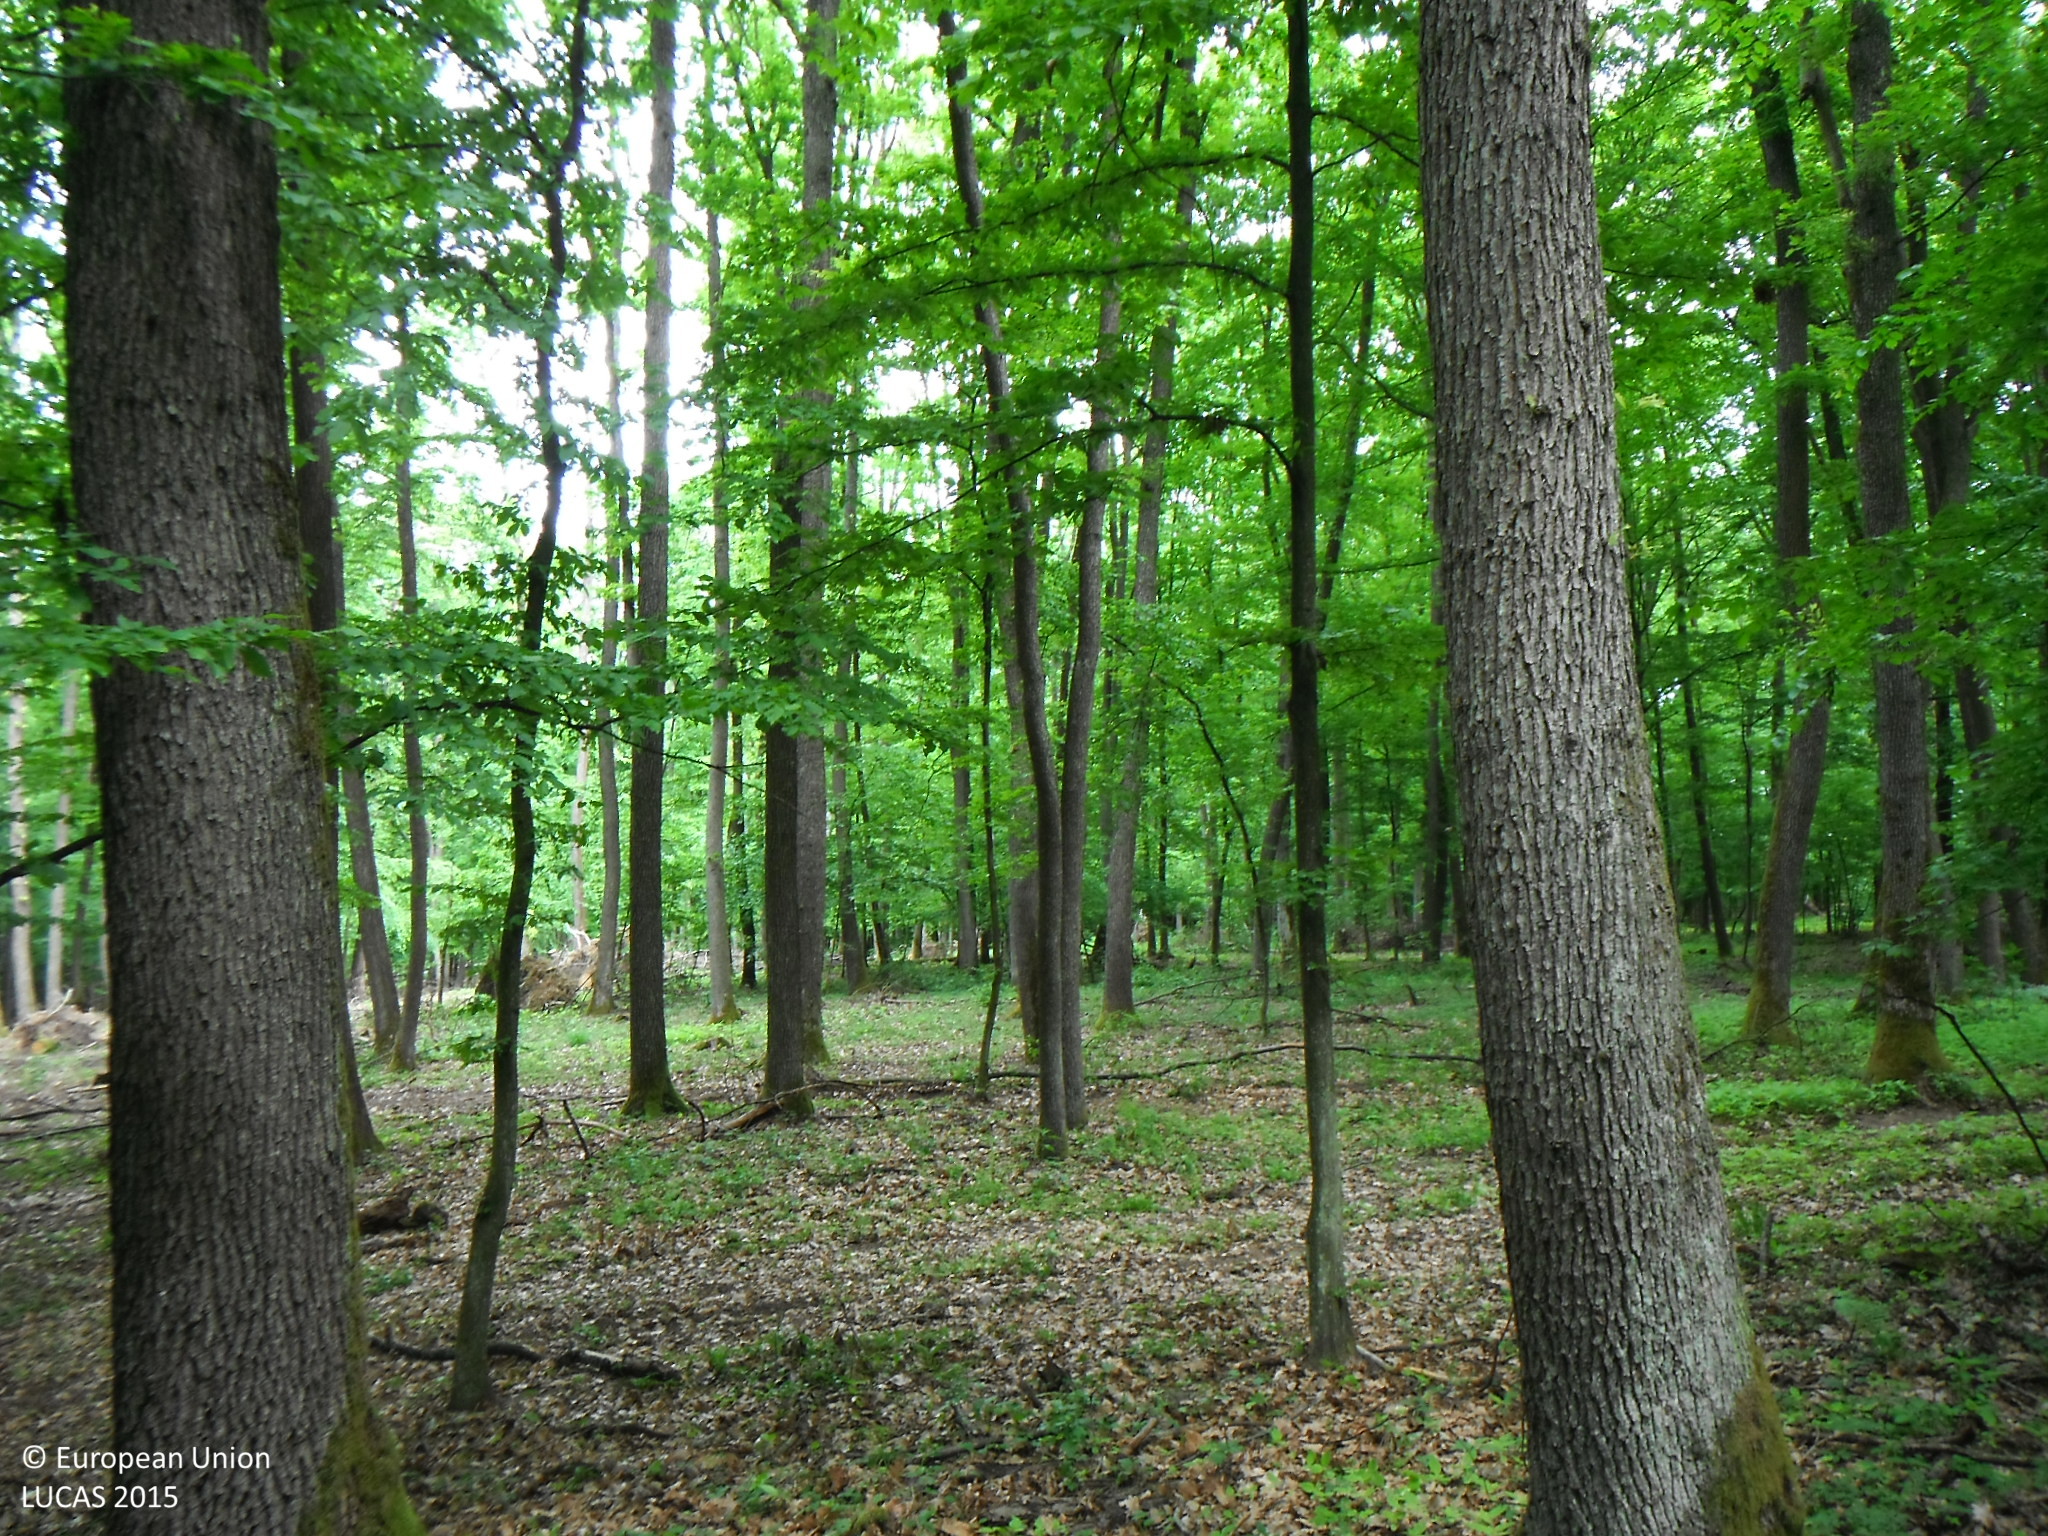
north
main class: Woodland
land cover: Broadleaved woodland
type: acidophilous oak and oak-birch forest
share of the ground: > 75 %
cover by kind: broadleaved forest trees 95 %, coniferous forest trees 5 %
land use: Forestry
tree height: > 5 m
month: May
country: SK
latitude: 48.6469
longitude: 21.0494
